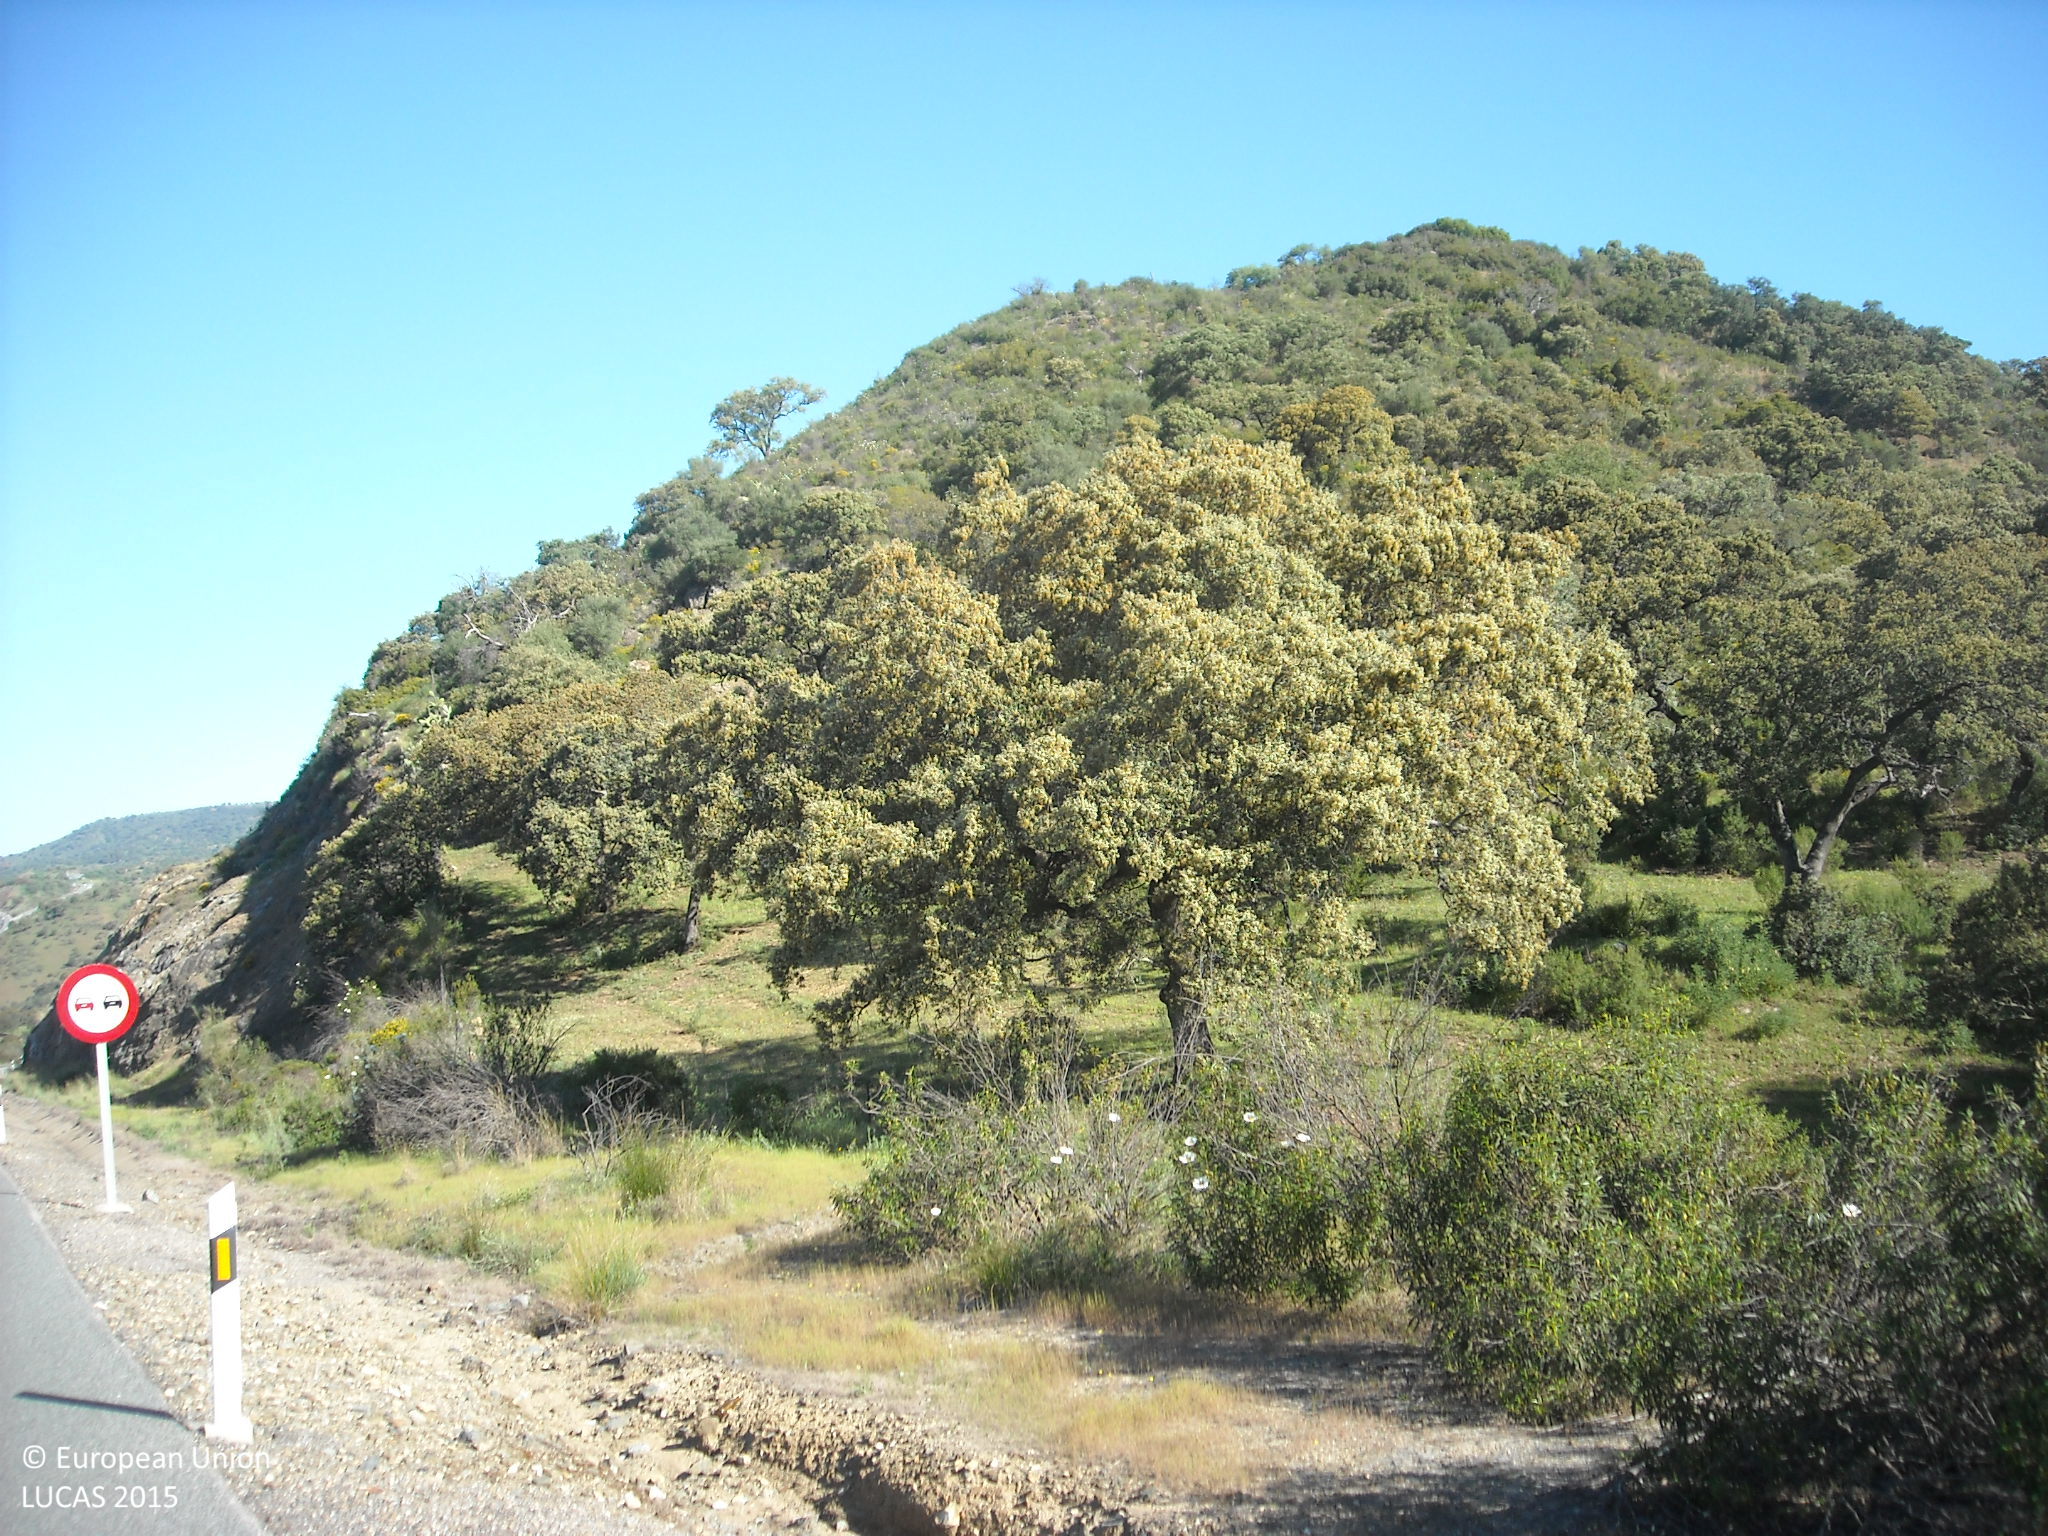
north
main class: Woodland
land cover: Broadleaved woodland
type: broadleaved evergreen forest
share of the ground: 10 - 25 %
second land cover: Grassland without tree/shrub cover
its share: > 75 %
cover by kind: herbaceous plants 75 %, broadleaved forest trees 25 %
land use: Forestry
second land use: Agriculture (excluding fallow land and kitchen gardens)
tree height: > 5 m
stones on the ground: < 10 %
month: April
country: ES
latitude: 37.6643
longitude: -6.1635
